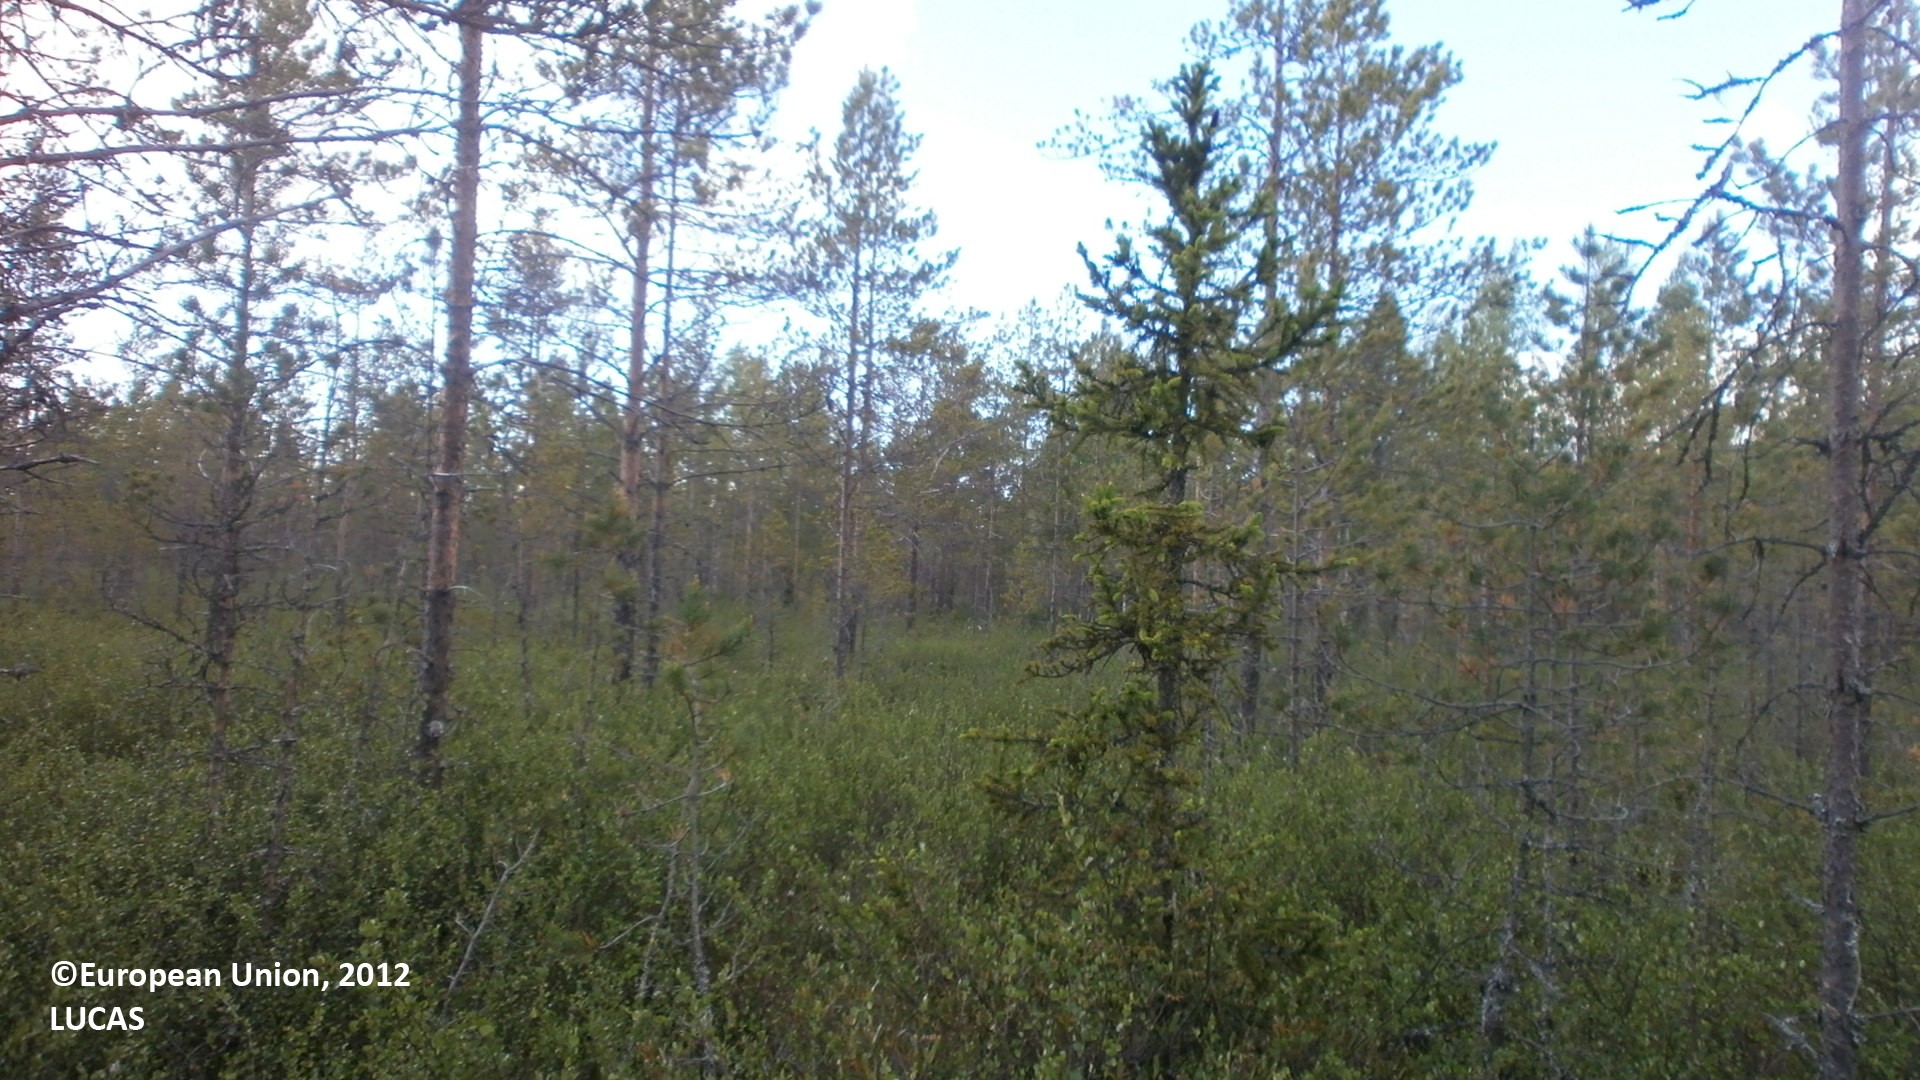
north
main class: Woodland
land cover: Pine dominated coniferous woodland
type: mire and swamp forests
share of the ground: 25 - 50 %
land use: Forestry
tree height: > 5 m
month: June
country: FI
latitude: 64.0503
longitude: 25.7289
